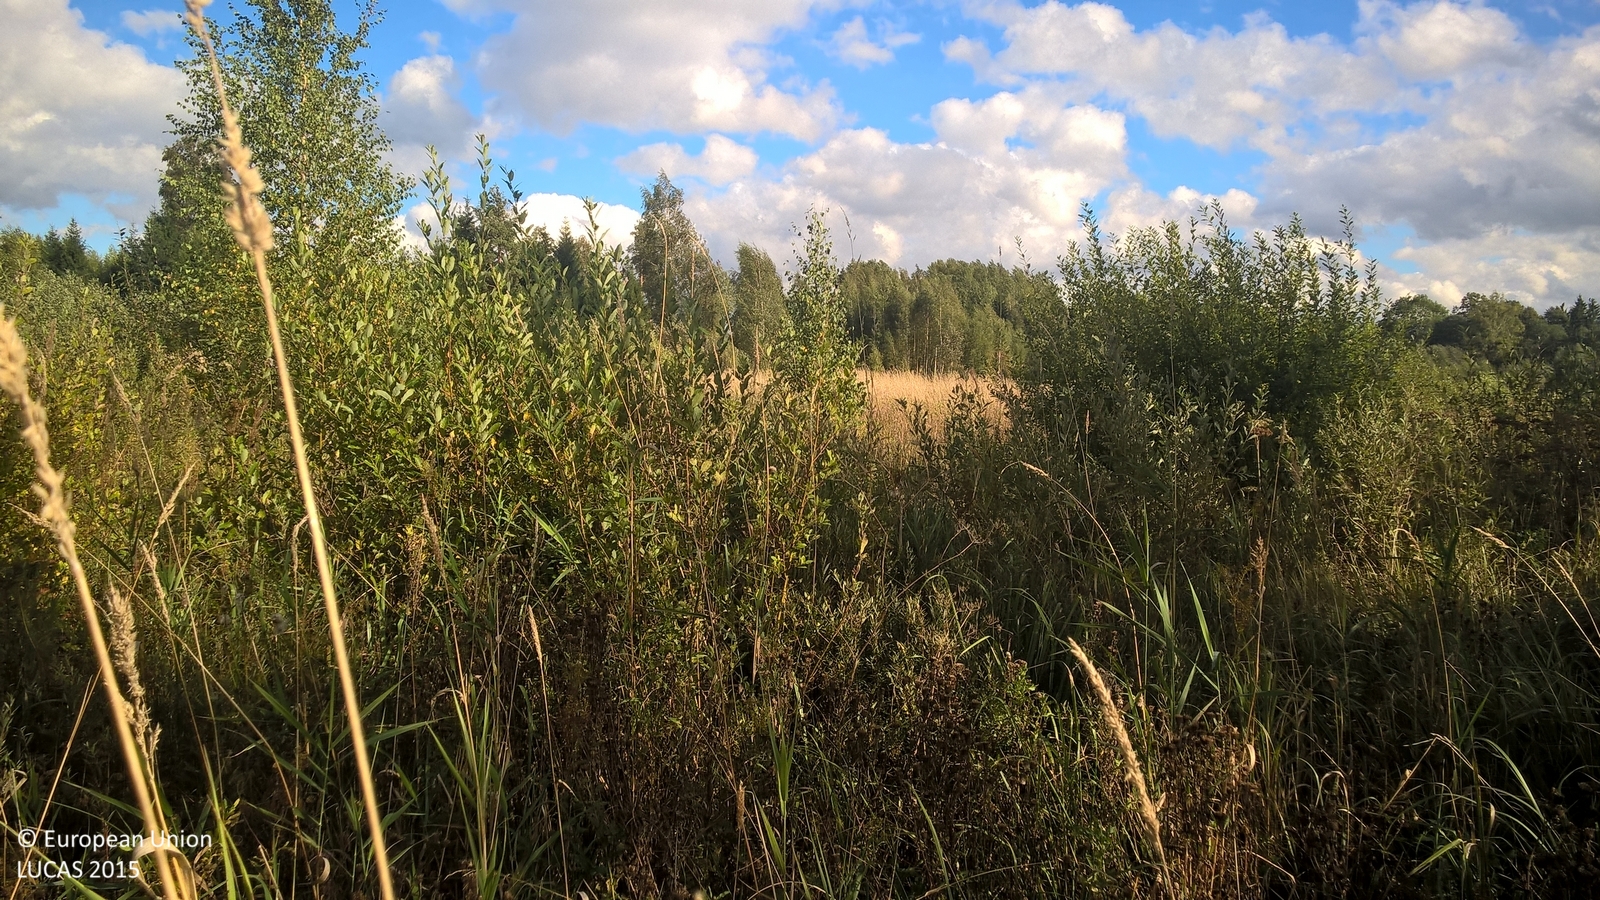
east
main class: Woodland
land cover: Broadleaved woodland
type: non-riverine alder, birch or aspen forest
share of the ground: 10 - 25 %
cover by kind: shrubs 60 %, broadleaved forest trees 20 %, lichens and mosses 20 %
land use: Forestry
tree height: > 5 m
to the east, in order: Broadleaved woodland; Spontaneously vegetated surfaces; Ditches and canals; Spontaneously vegetated surfaces; Broadleaved woodland; Other mixed woodland
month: September
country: LV
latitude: 57.5635
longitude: 25.8540
